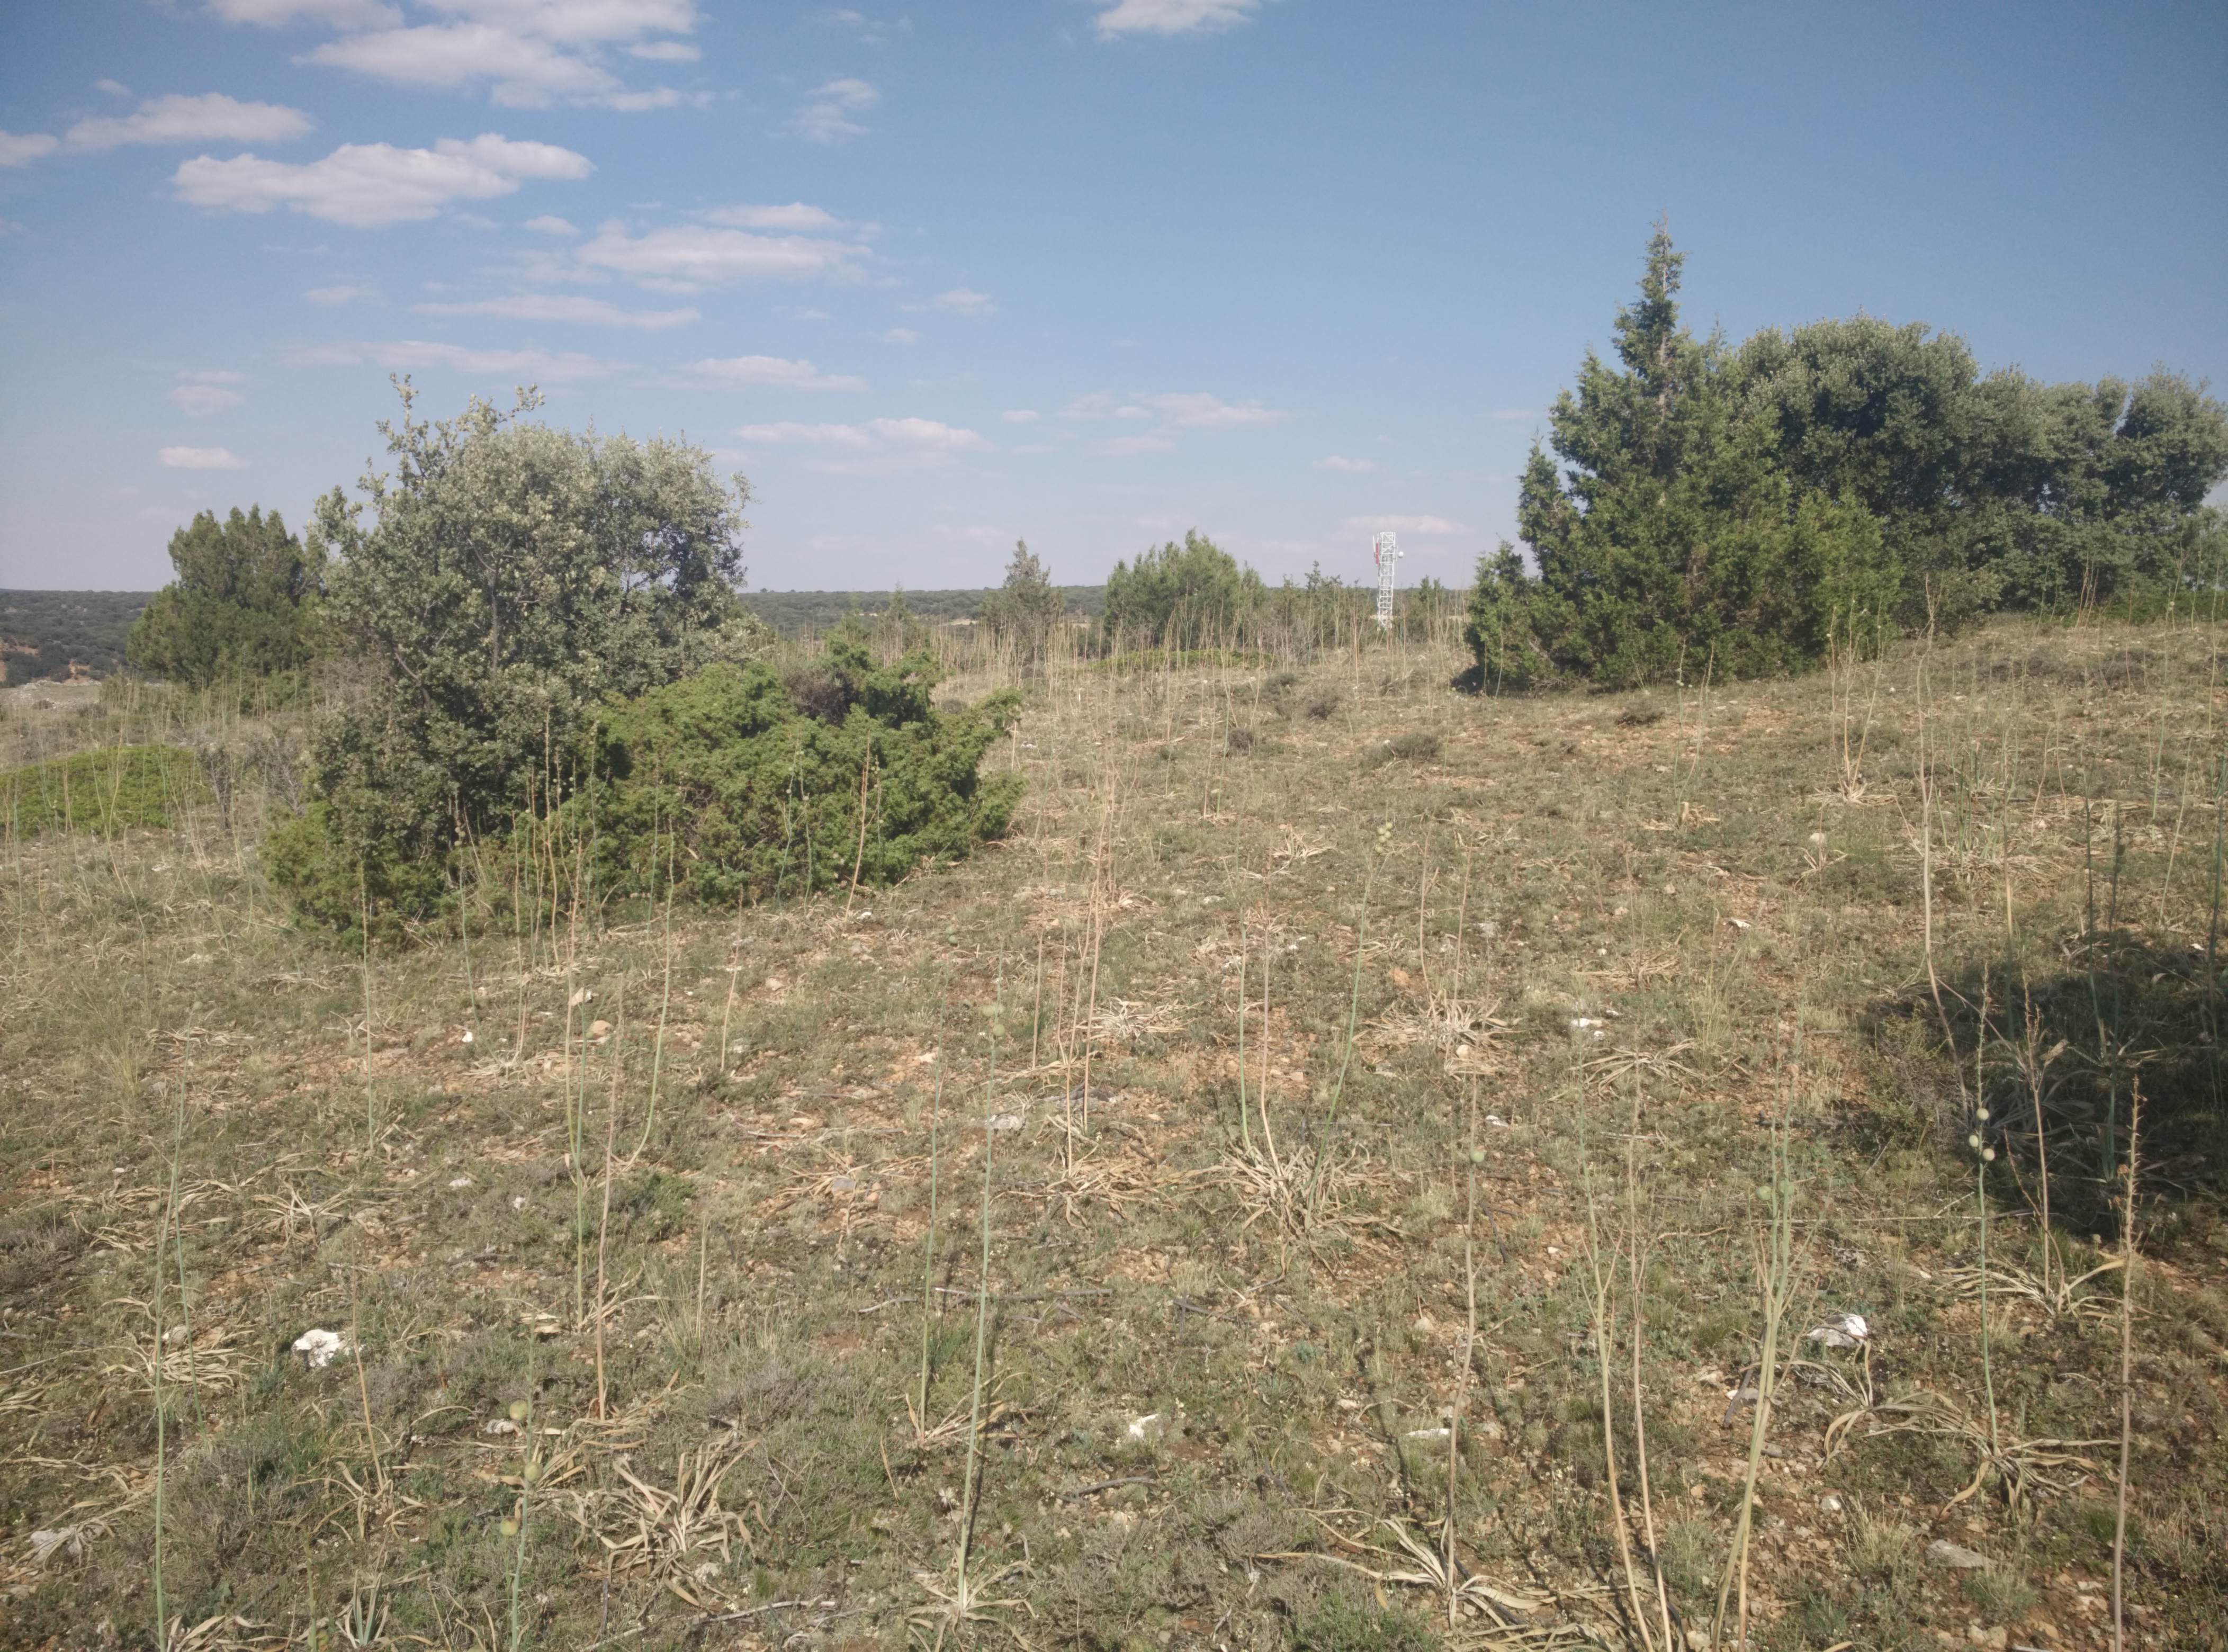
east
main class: Shrubland
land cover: Shrubland with sparse tree cover
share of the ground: 25 - 50 %
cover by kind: herbaceous plants 55 %, shrubs 25 %, unconsolidated bare surface 15 %, coniferous forest trees 5 %
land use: Semi-natural and natural areas not in use
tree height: < 5 m
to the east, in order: Shrubland with sparse tree cover; Rock outcrops; Shrubland with sparse tree cover; Shrubland without tree cover; Rock outcrops; Shrubland without tree cover; Paved roads, cycling and walking lanes; Shrubland without tree cover; Electric lines; Shrubland with sparse tree cover
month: June
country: ES
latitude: 40.6649
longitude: -1.8129
